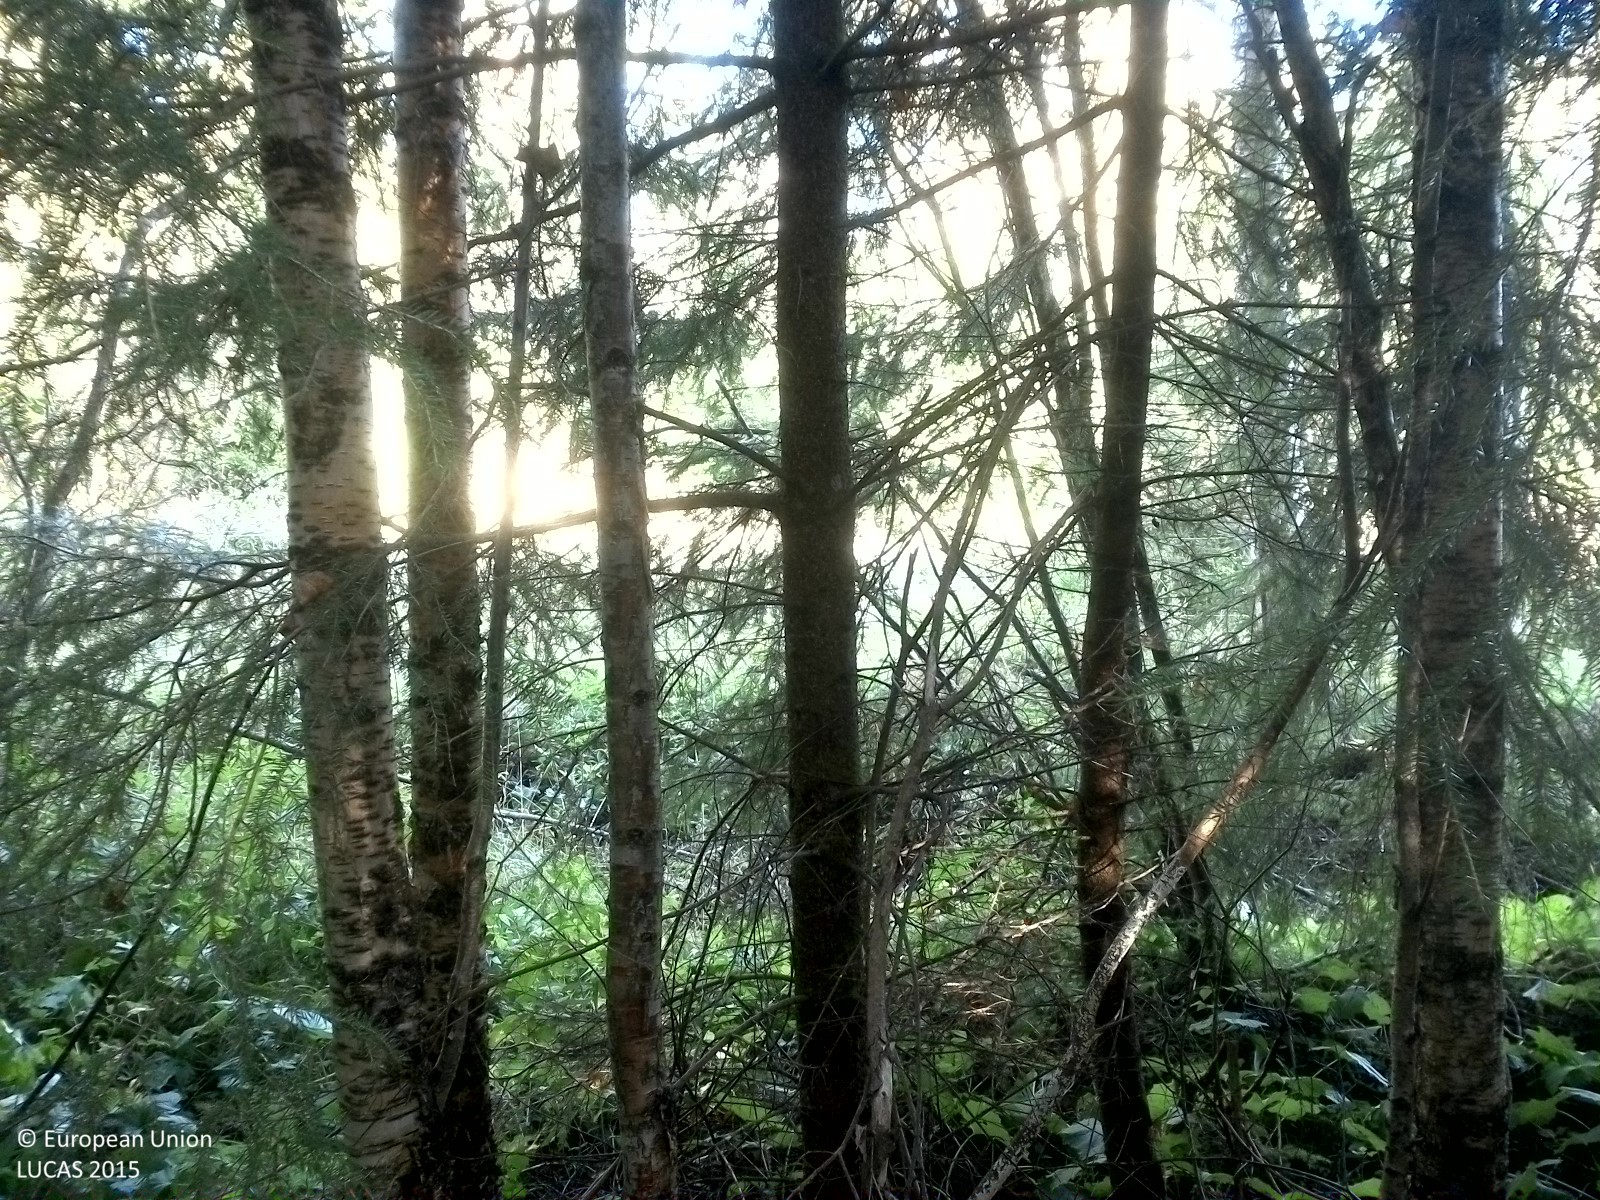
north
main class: Woodland
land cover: Spruce dominated mixed woodland
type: boreal forest
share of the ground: 50 - 75 %
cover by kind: herbaceous plants 35 %, coniferous forest trees 30 %, broadleaved forest trees 20 %, unconsolidated bare surface 10 %, lichens and mosses 5 %
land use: Forestry
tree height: > 5 m
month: September
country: SE
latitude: 58.9732
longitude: 15.0192
